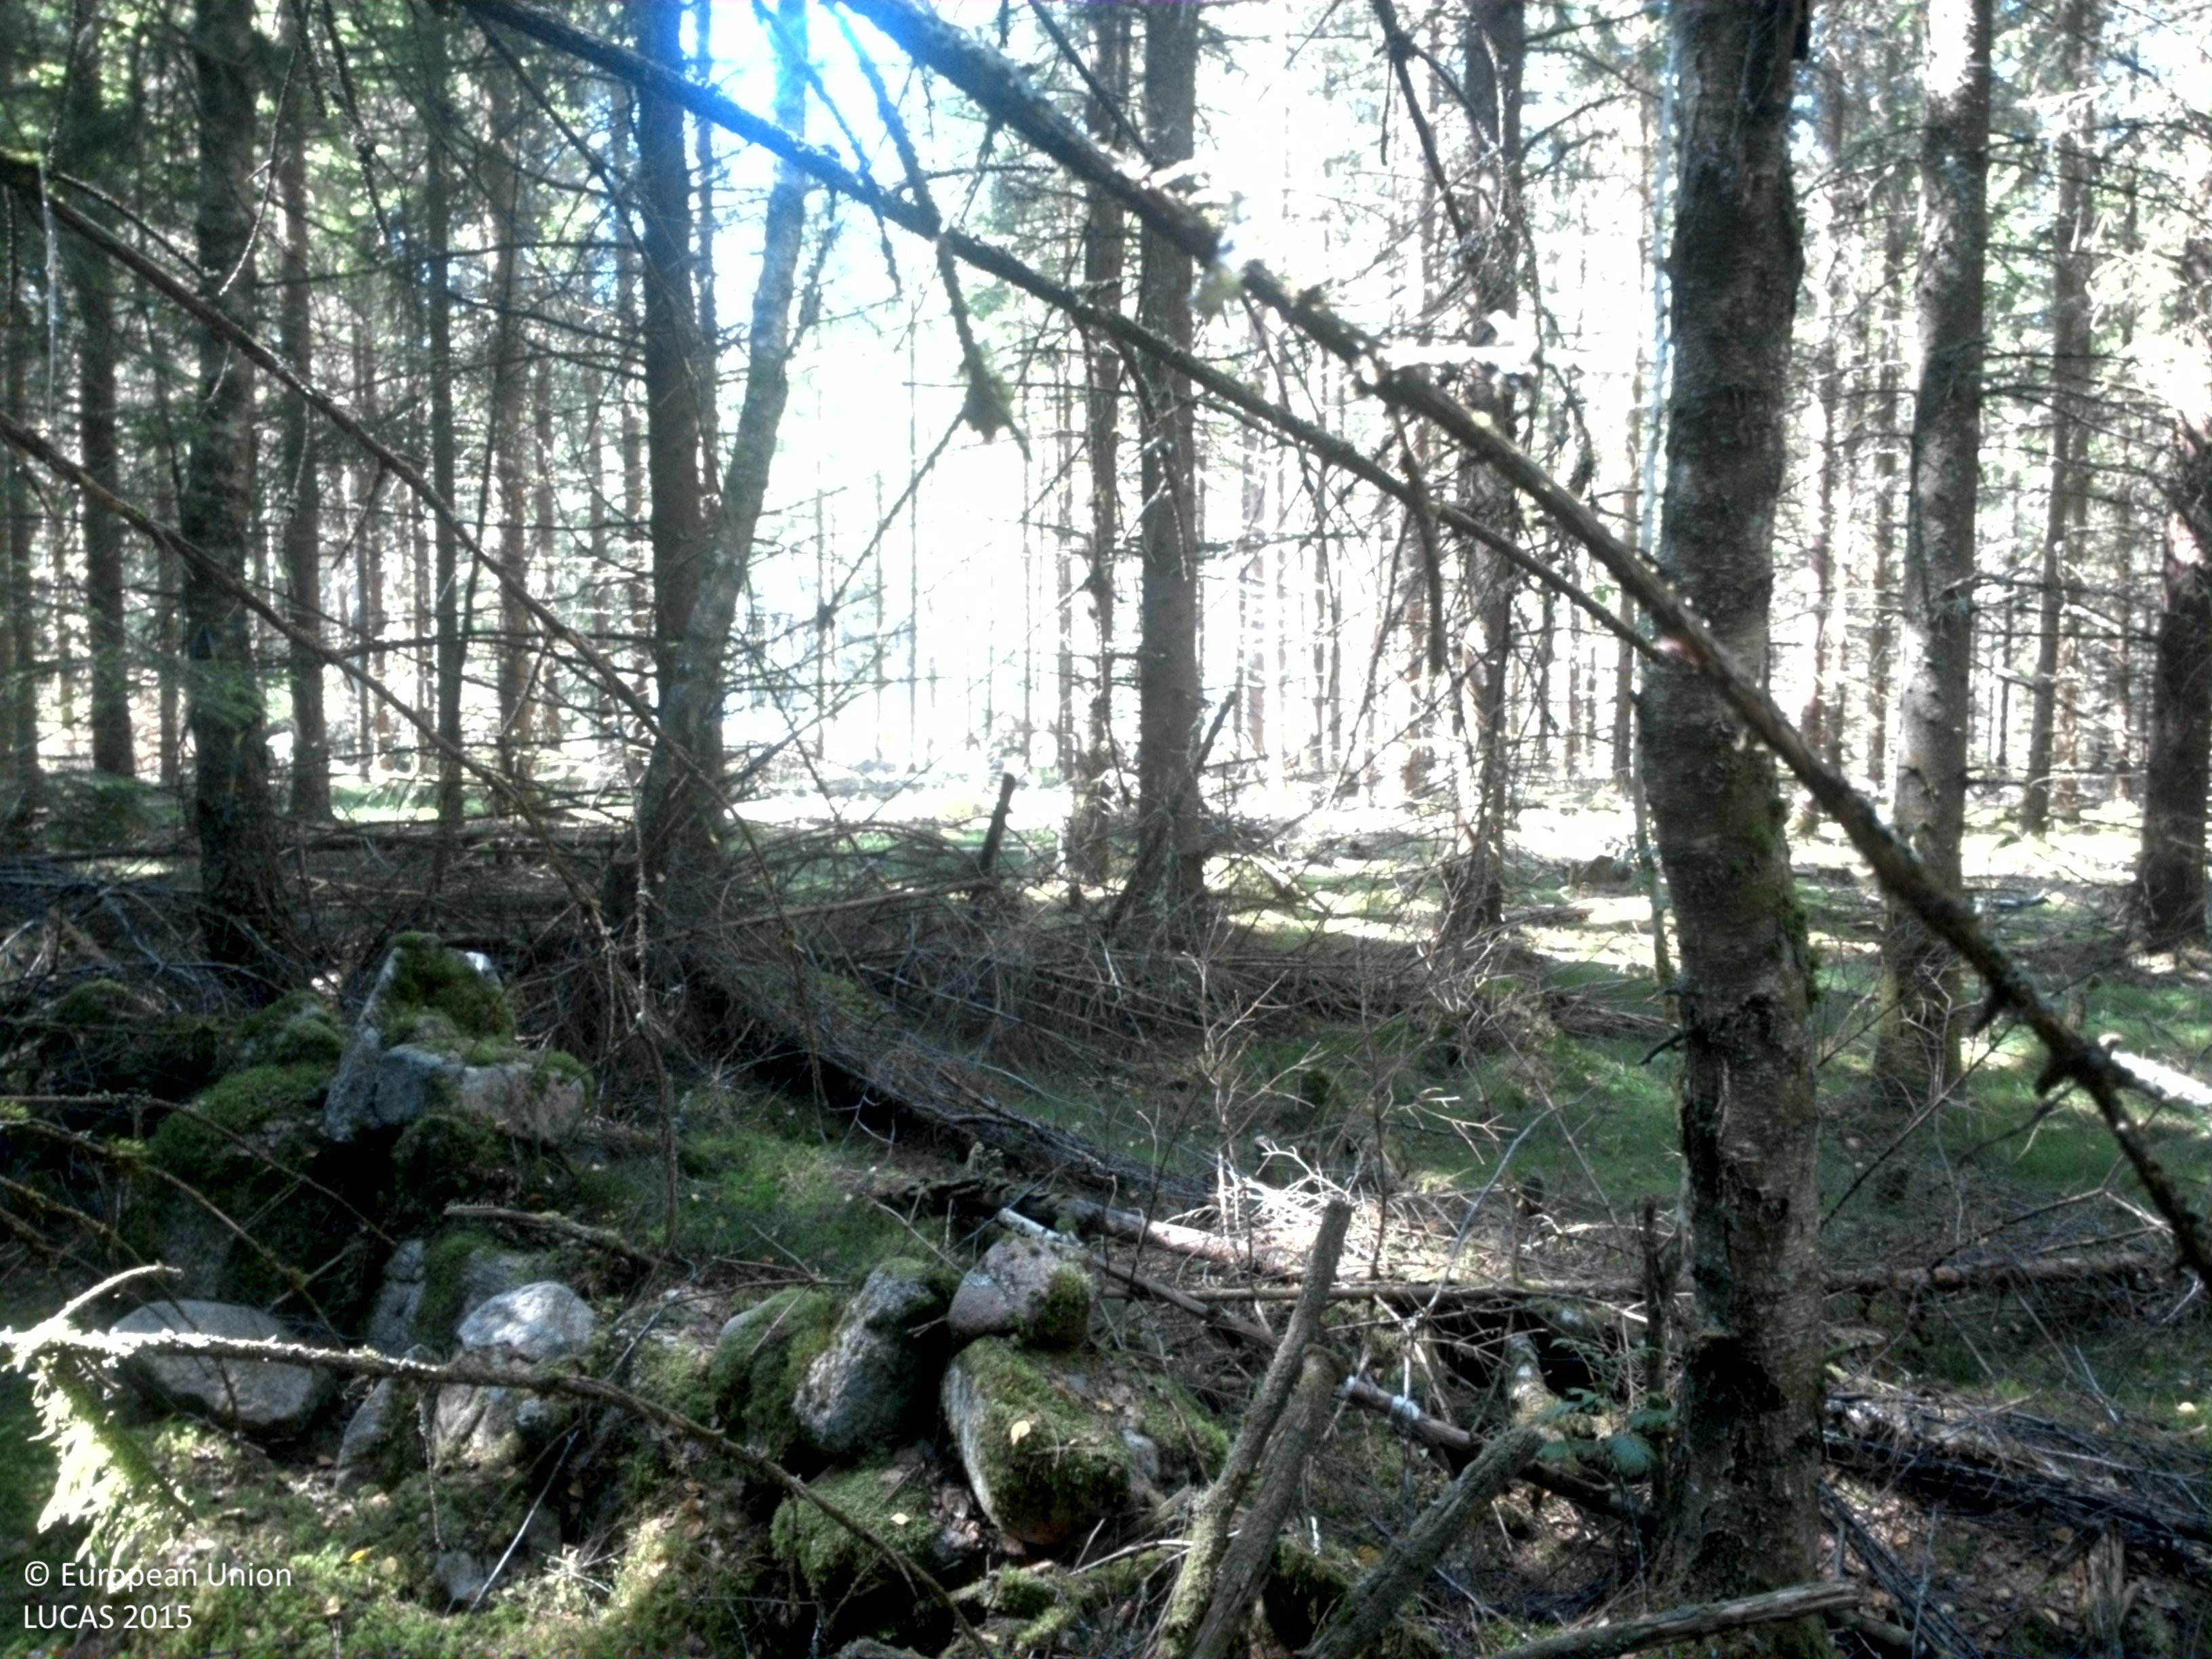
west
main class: Woodland
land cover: Spruce dominated coniferous woodland
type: boreal forest
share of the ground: 50 - 75 %
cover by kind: coniferous forest trees 50 %, lichens and mosses 45 %, broadleaved forest trees 5 %
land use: Forestry
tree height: > 5 m
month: August
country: SE
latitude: 58.0547
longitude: 13.2314
